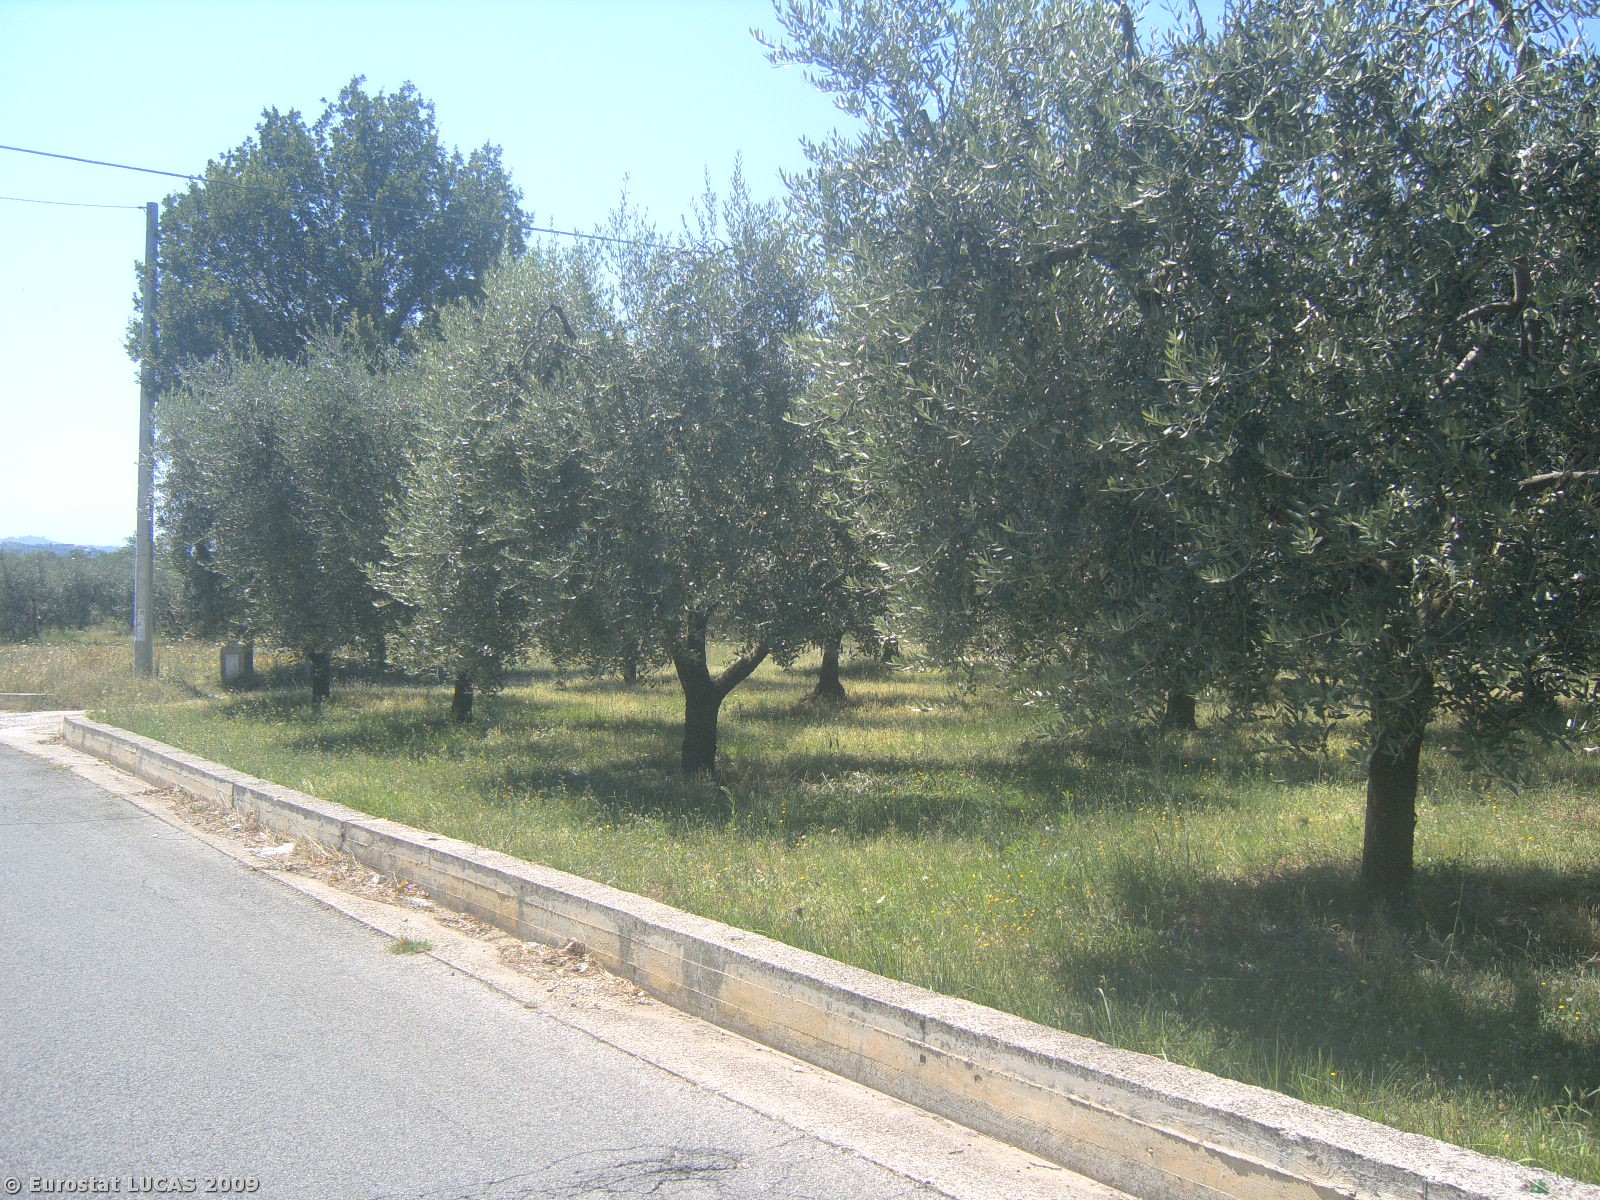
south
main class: Grassland
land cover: Grassland with sparse tree/shrub cover
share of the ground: 25 - 50 %
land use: Residential
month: July
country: IT
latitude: 41.7121
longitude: 13.3648
